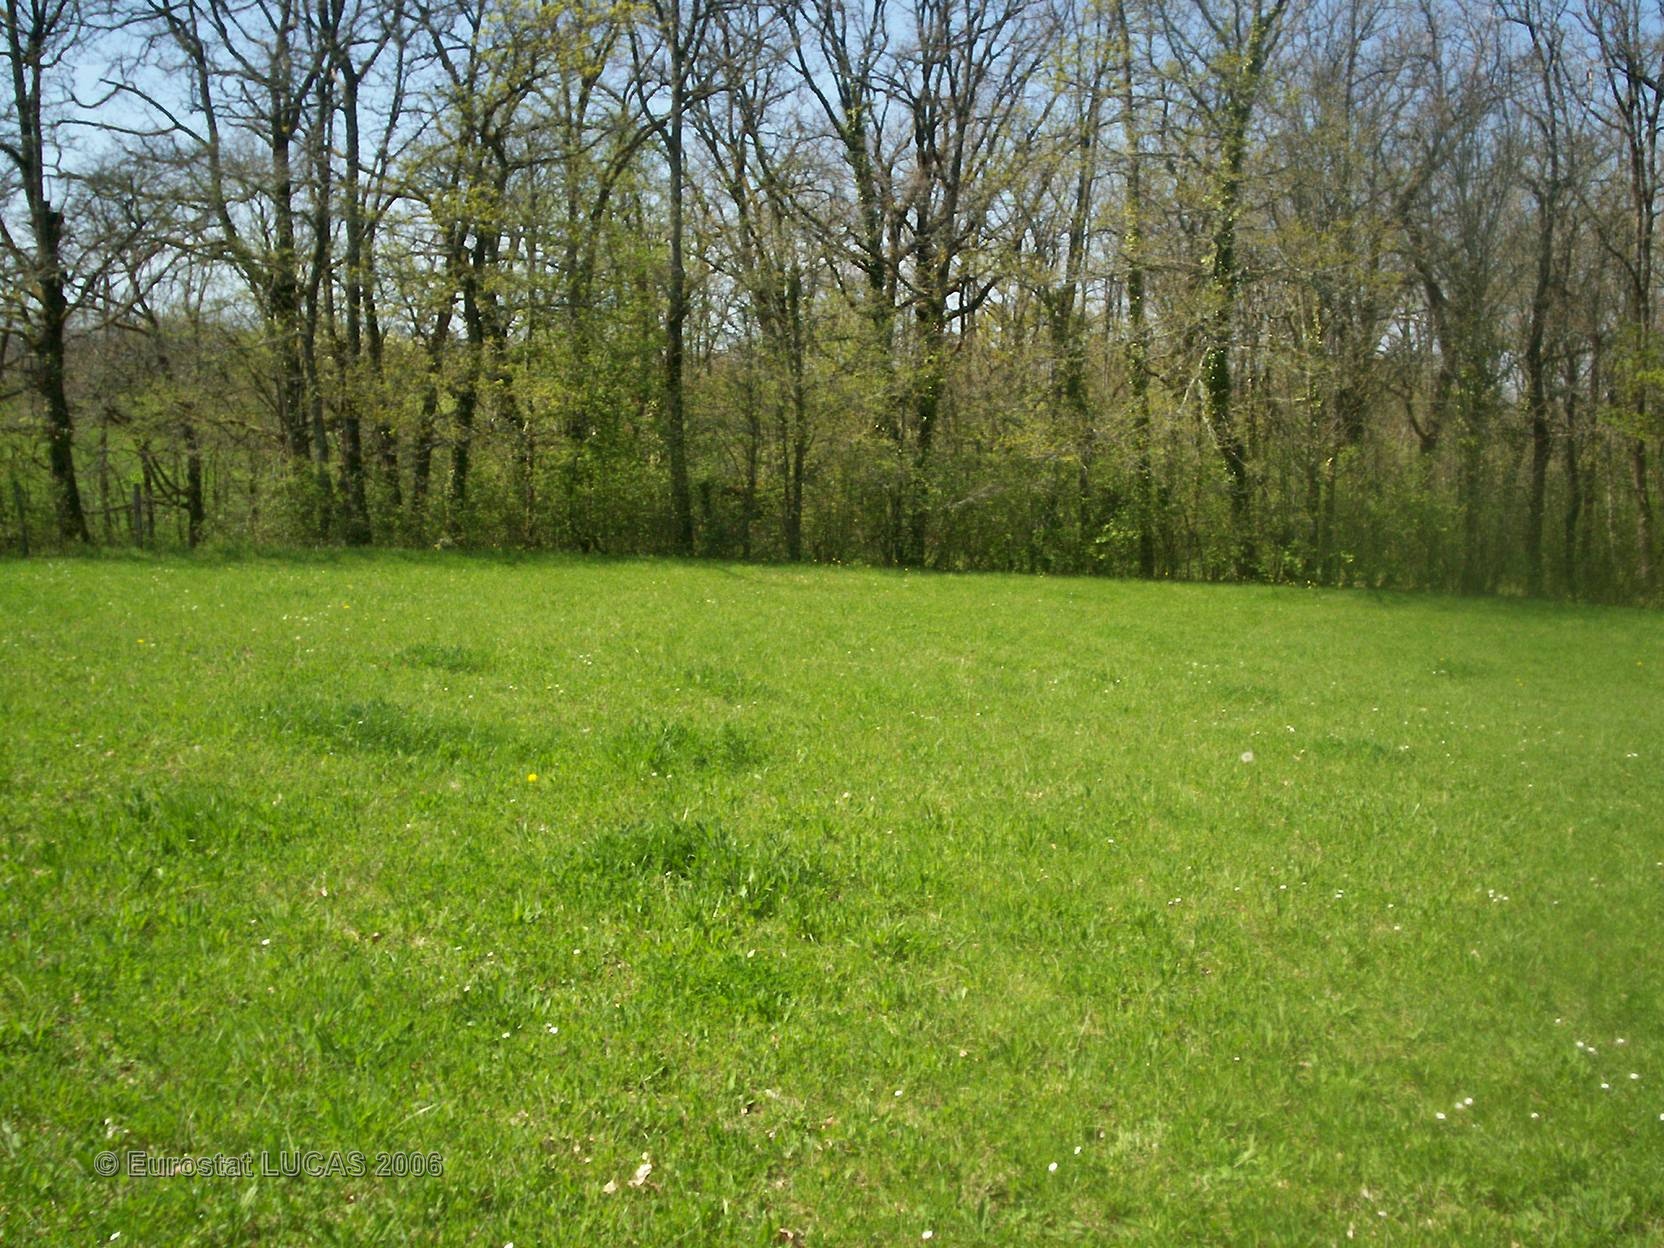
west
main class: Grassland
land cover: Grassland without tree/shrub cover
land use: Agriculture (excluding fallow land and kitchen gardens)
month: April
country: FR
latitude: 44.3782
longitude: 1.9054
